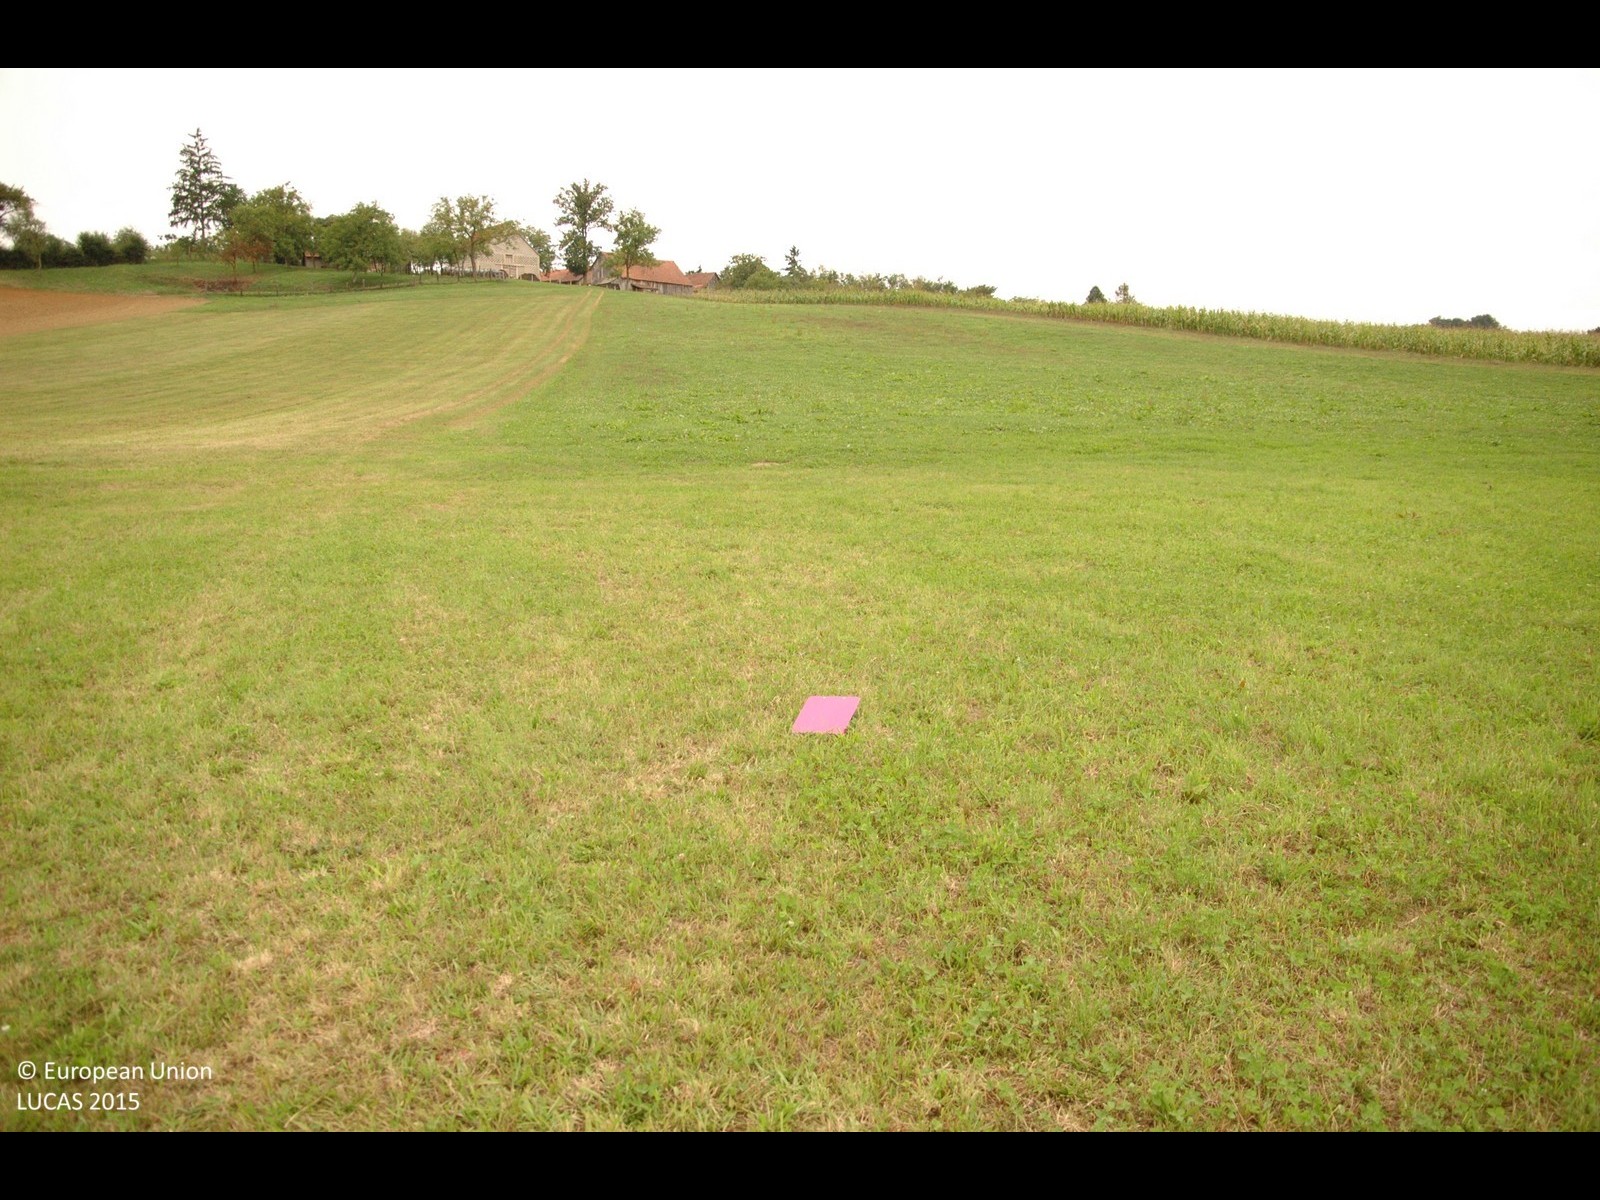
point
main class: Grassland
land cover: Grassland without tree/shrub cover
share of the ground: > 75 %
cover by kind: herbaceous plants 100 %
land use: Agriculture (excluding fallow land and kitchen gardens)
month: September
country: HR
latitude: 46.0649
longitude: 16.7618
